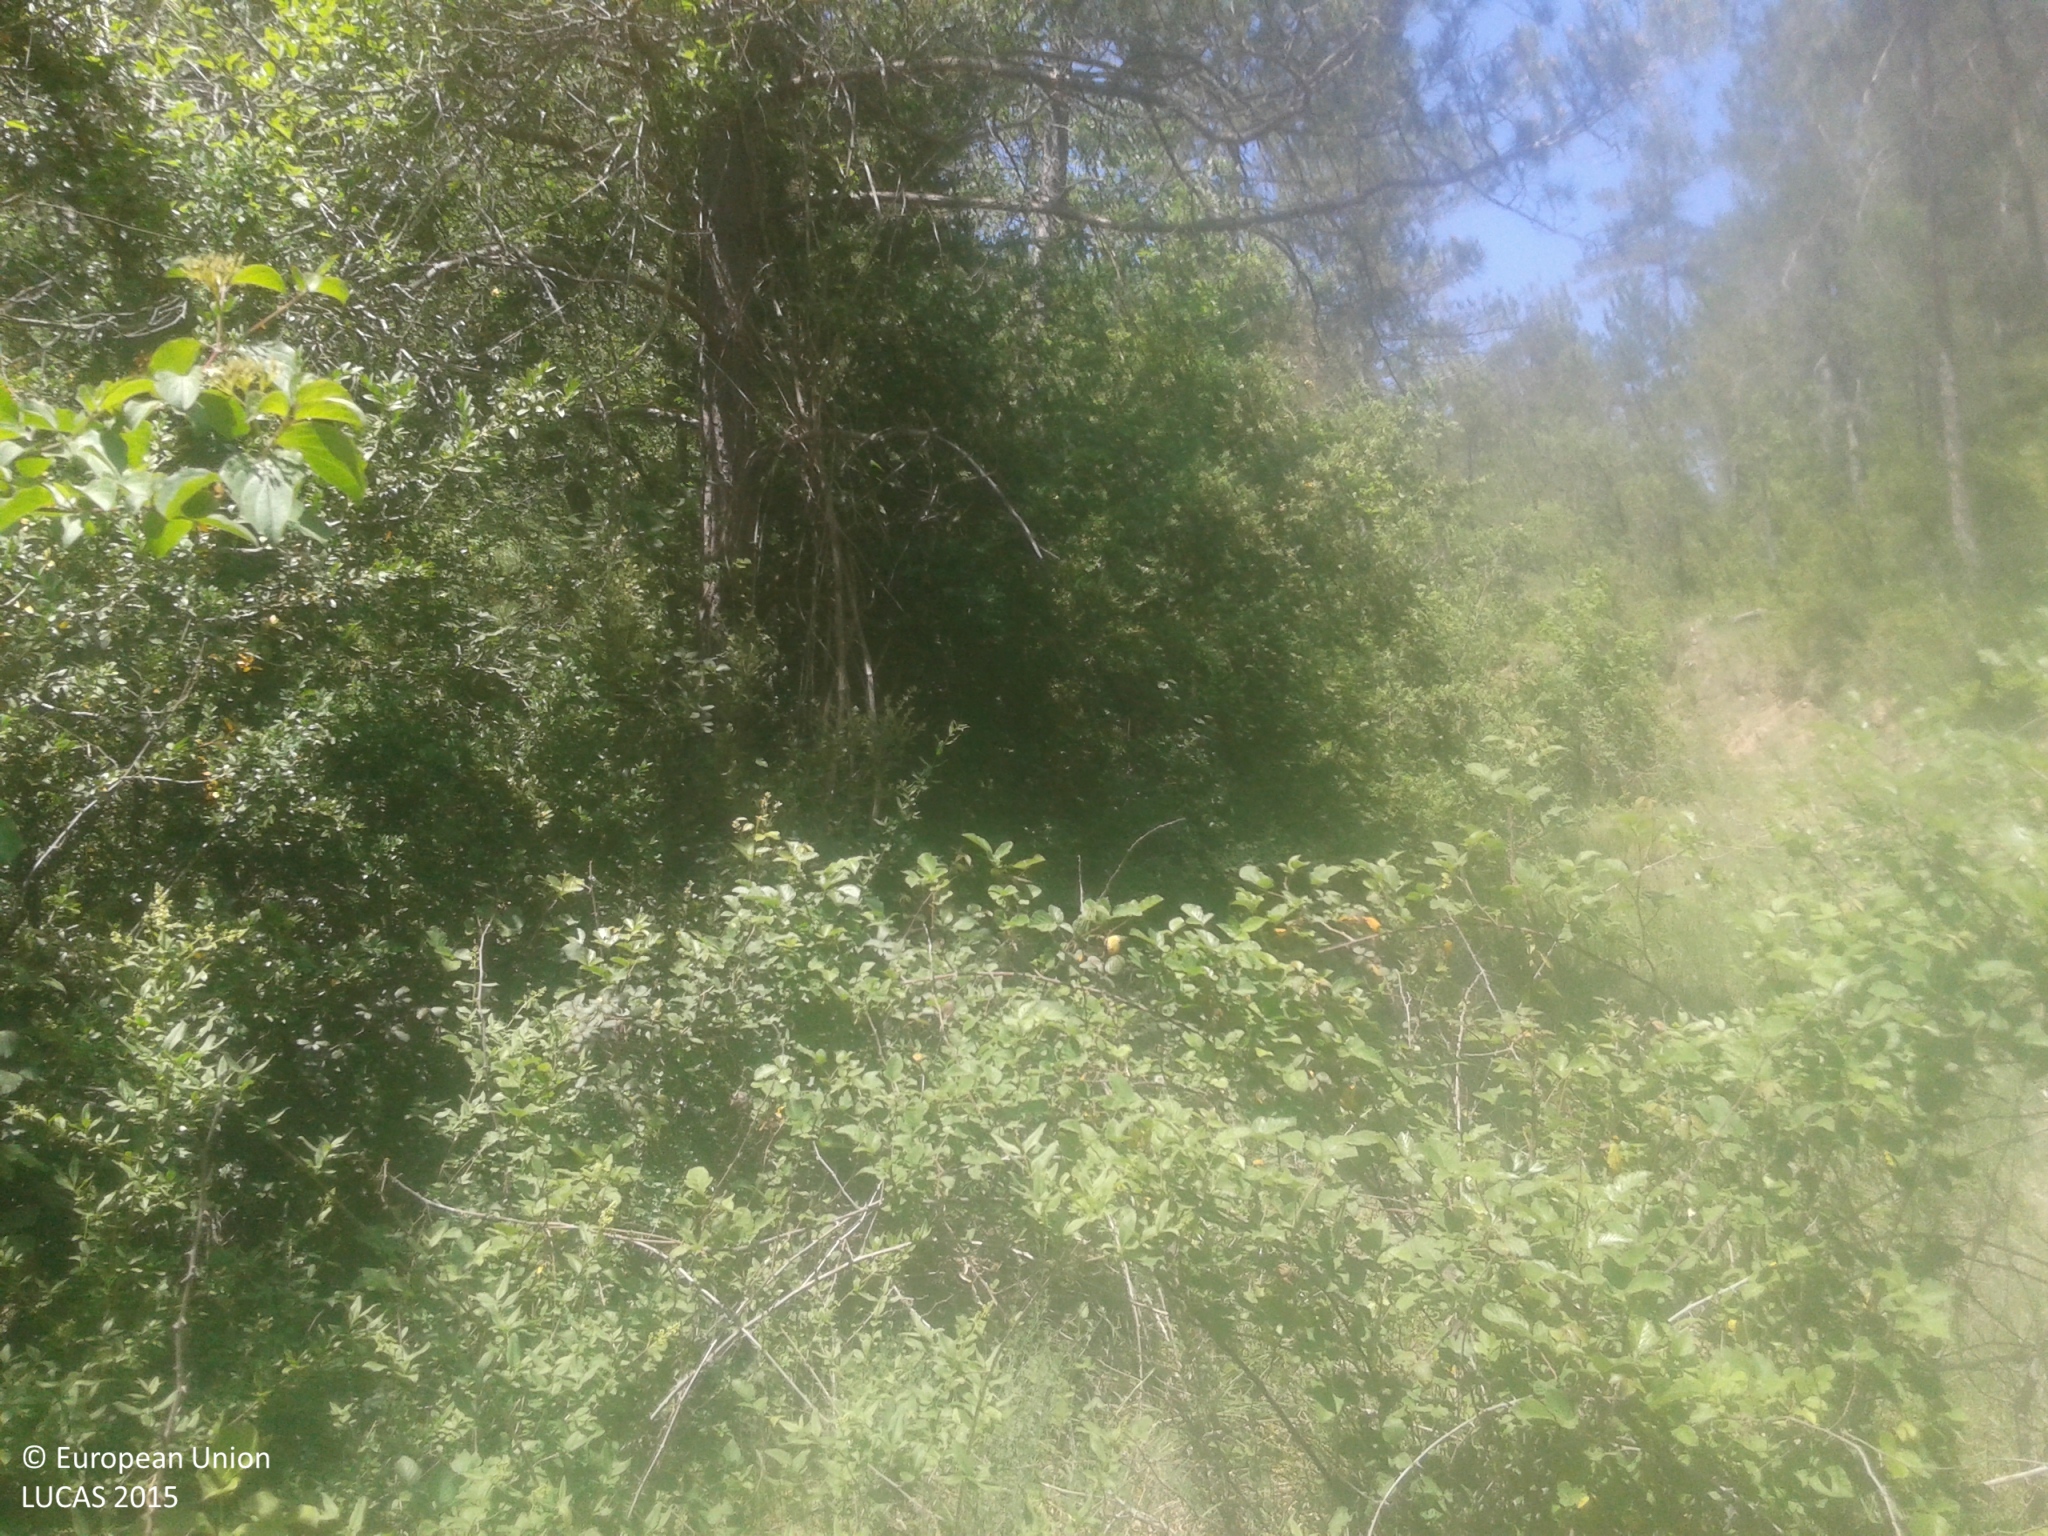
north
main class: Woodland
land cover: Pine dominated mixed woodland
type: coniferous forest of the mediterranean region
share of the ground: > 75 %
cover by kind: coniferous forest trees 55 %, broadleaved forest trees 20 %, shrubs 20 %, herbaceous plants 5 %
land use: Forestry
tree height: > 5 m
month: May
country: ES
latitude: 42.0338
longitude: 1.6176
